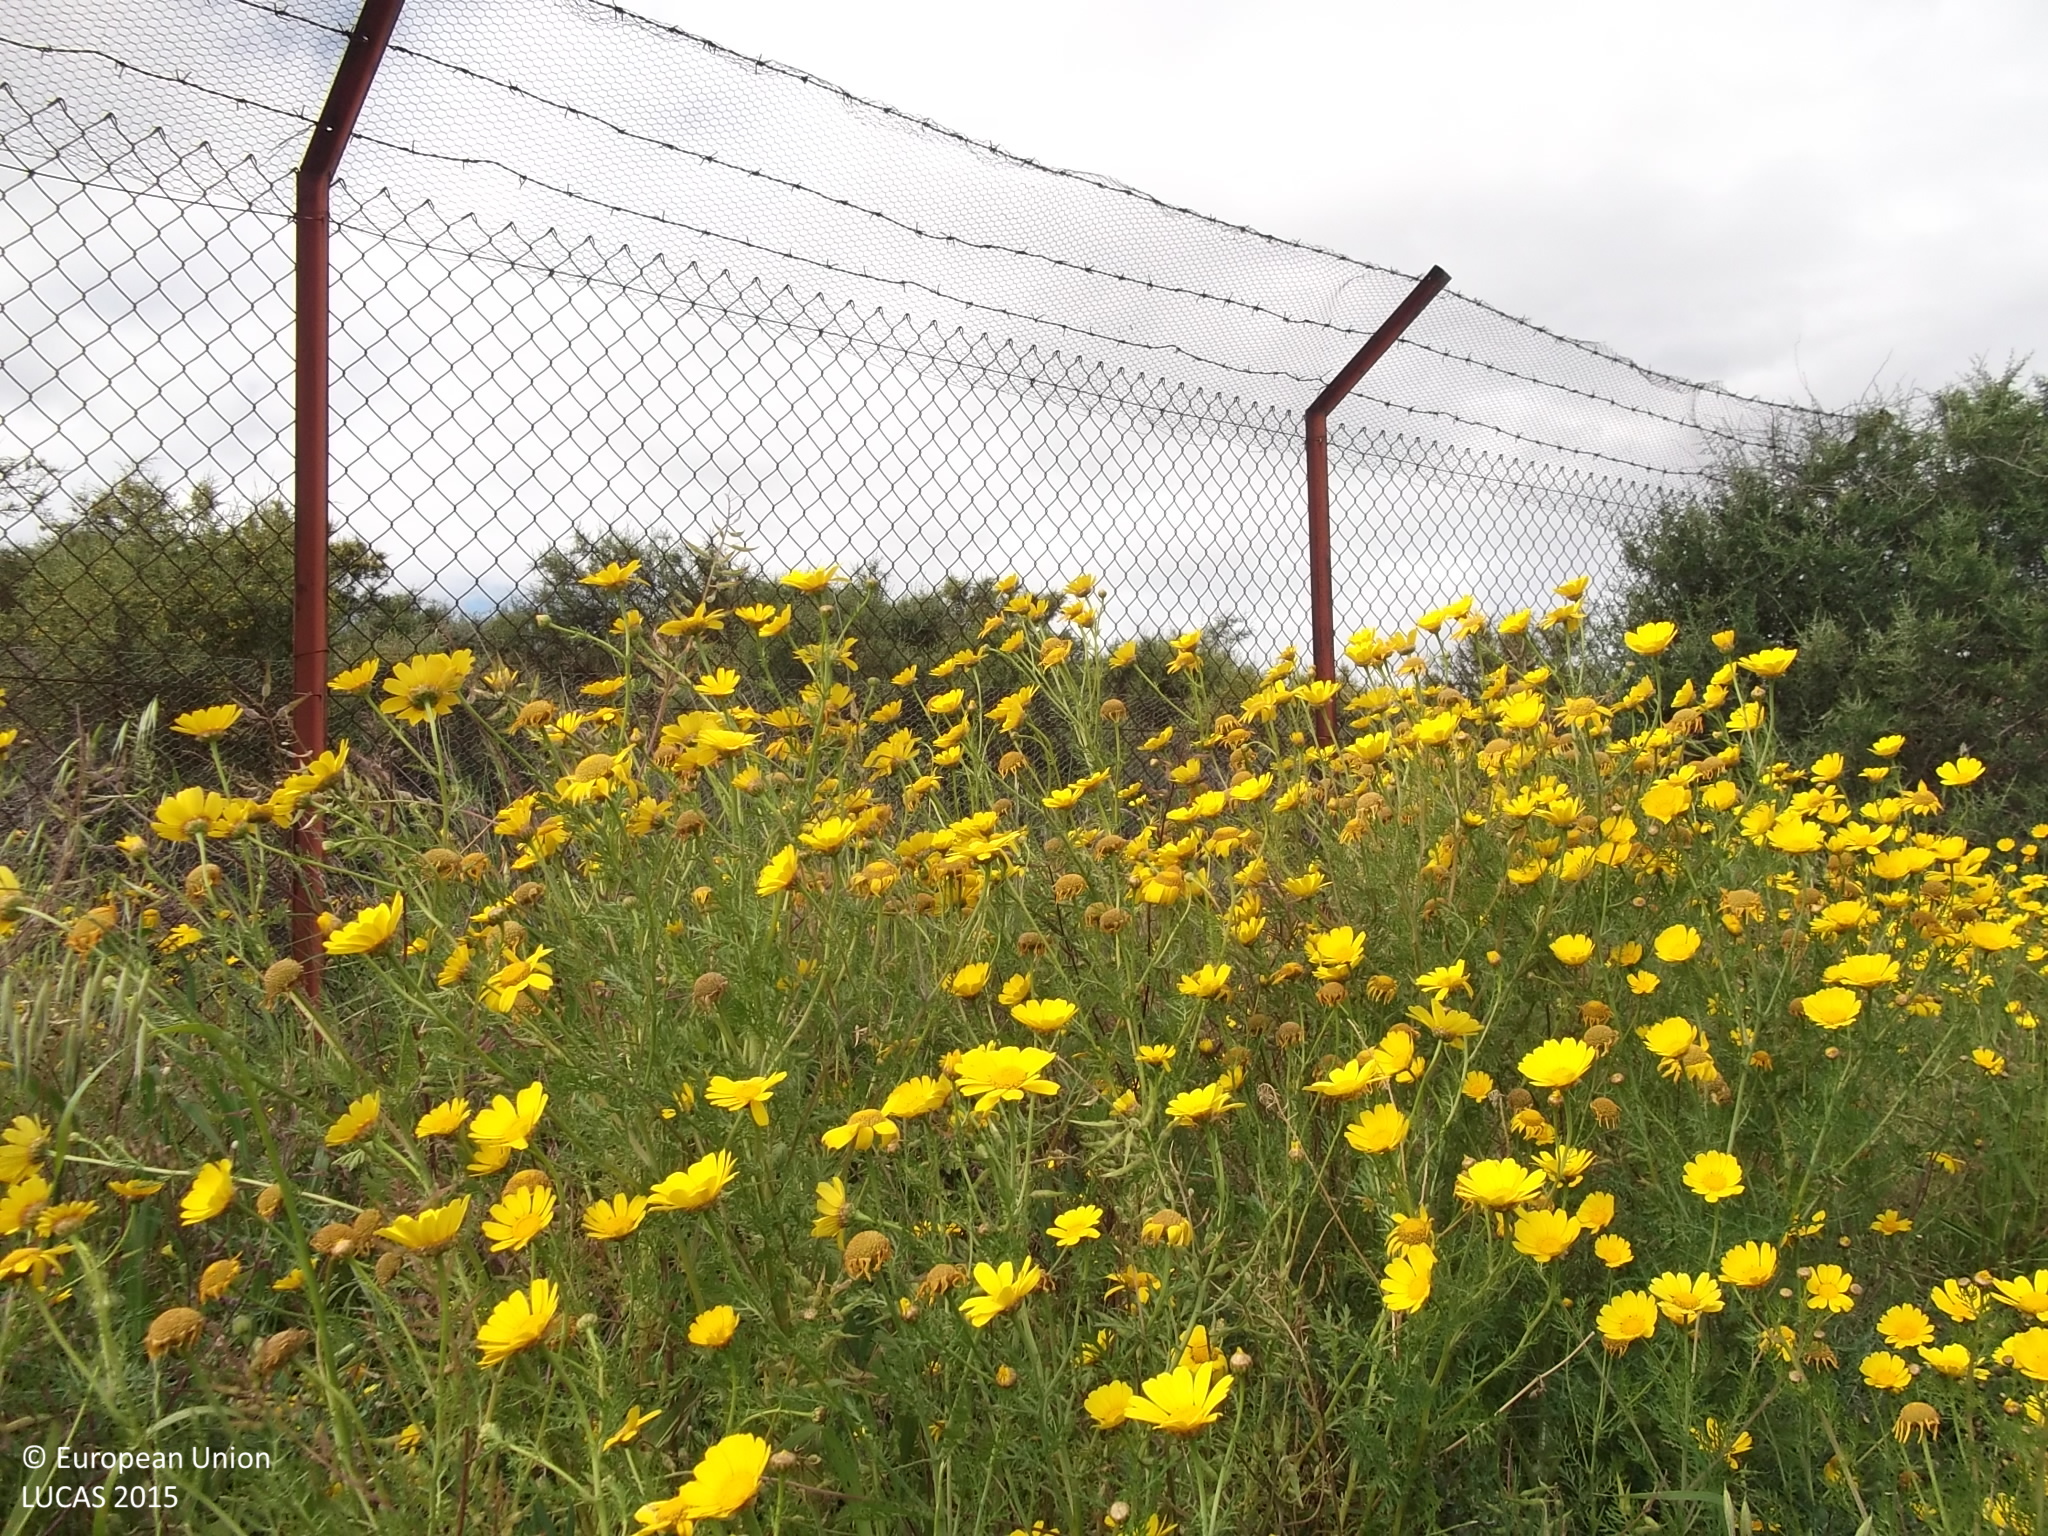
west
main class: Shrubland
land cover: Shrubland without tree cover
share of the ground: > 75 %
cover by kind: shrubs 80 %, herbaceous plants 20 %
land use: Semi-natural and natural areas not in use
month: April
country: CY
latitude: 34.8352
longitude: 33.4217
